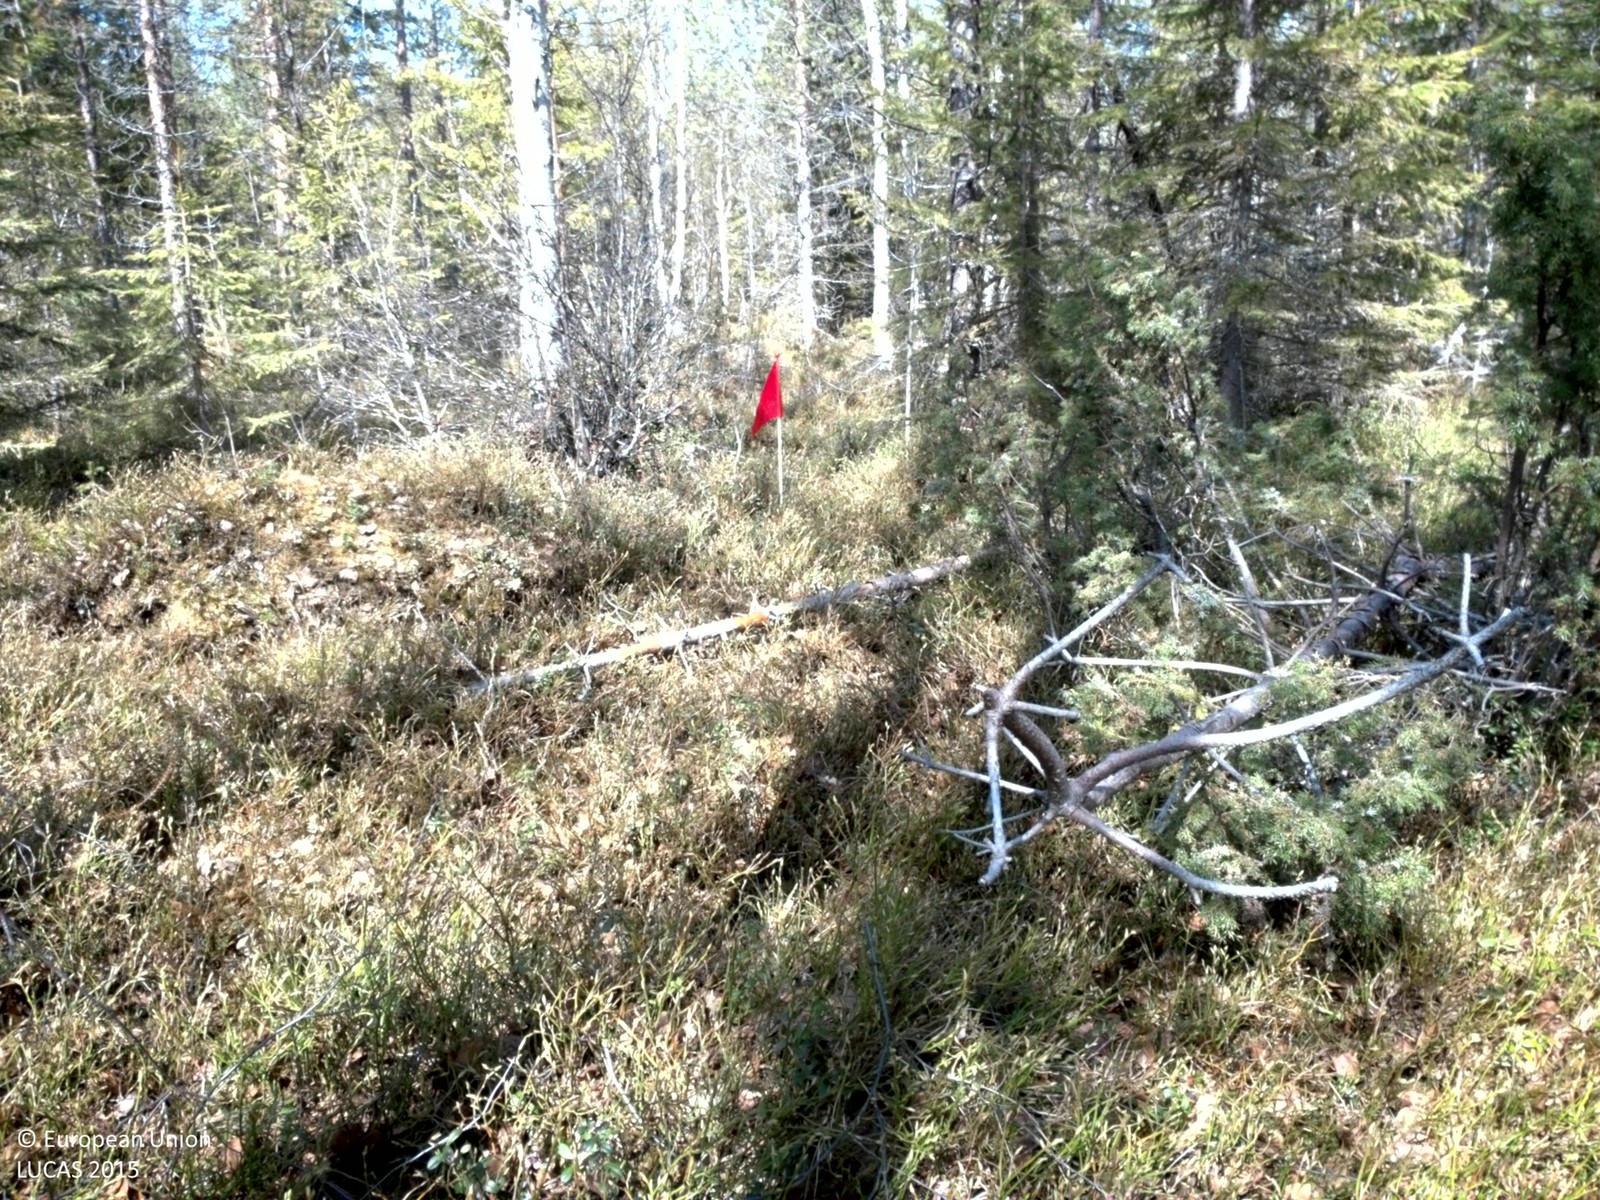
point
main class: Woodland
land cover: Pine dominated coniferous woodland
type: boreal forest
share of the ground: 50 - 75 %
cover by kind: coniferous forest trees 55 %, shrubs 35 %, broadleaved forest trees 10 %
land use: Forestry
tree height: < 5 m
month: May
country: SE
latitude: 66.1552
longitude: 23.2642
